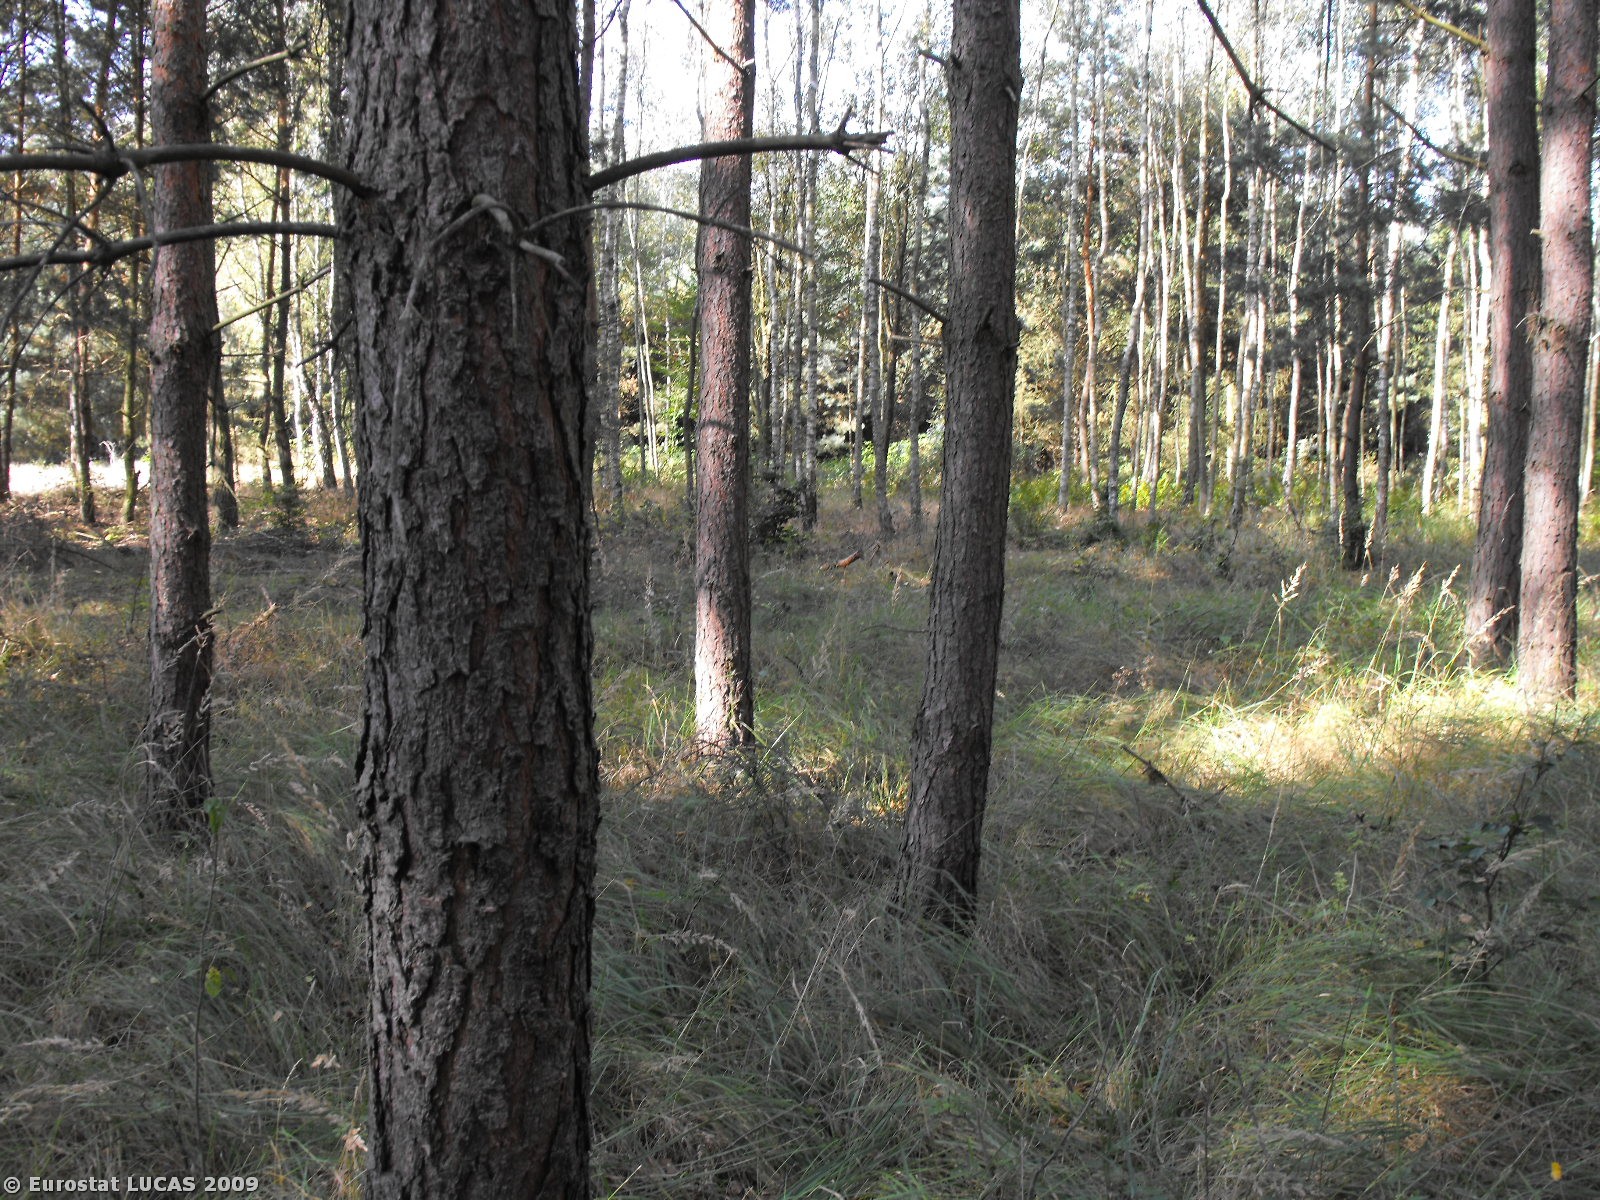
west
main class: Woodland
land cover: Coniferous woodland
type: hemiboreal forest and nemoral coniferous forest and mixed broadleaved-coniferous forest
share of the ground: > 75 %
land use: Forestry
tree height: > 5 m
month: September
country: PL
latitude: 52.3362
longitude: 16.3028
